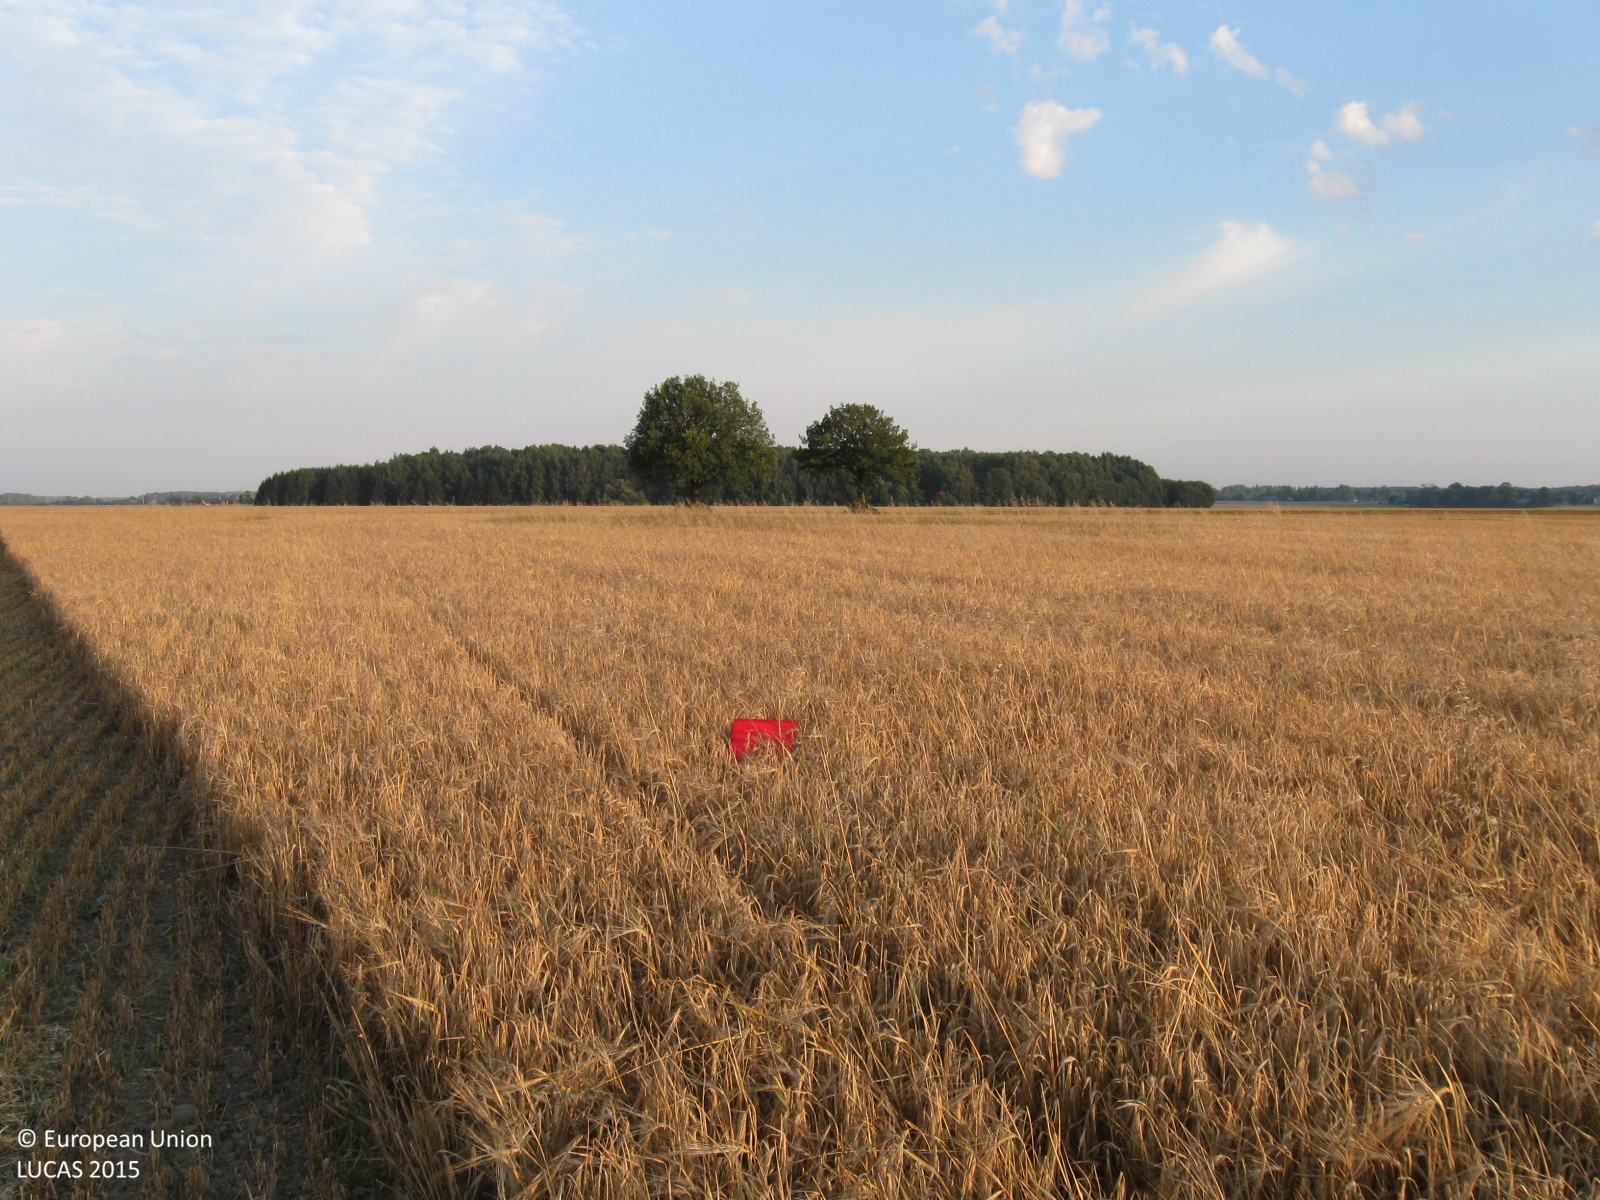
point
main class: Cropland
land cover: Barley
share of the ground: > 75 %
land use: Agriculture (excluding fallow land and kitchen gardens)
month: August
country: LT
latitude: 55.3694
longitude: 22.8961
